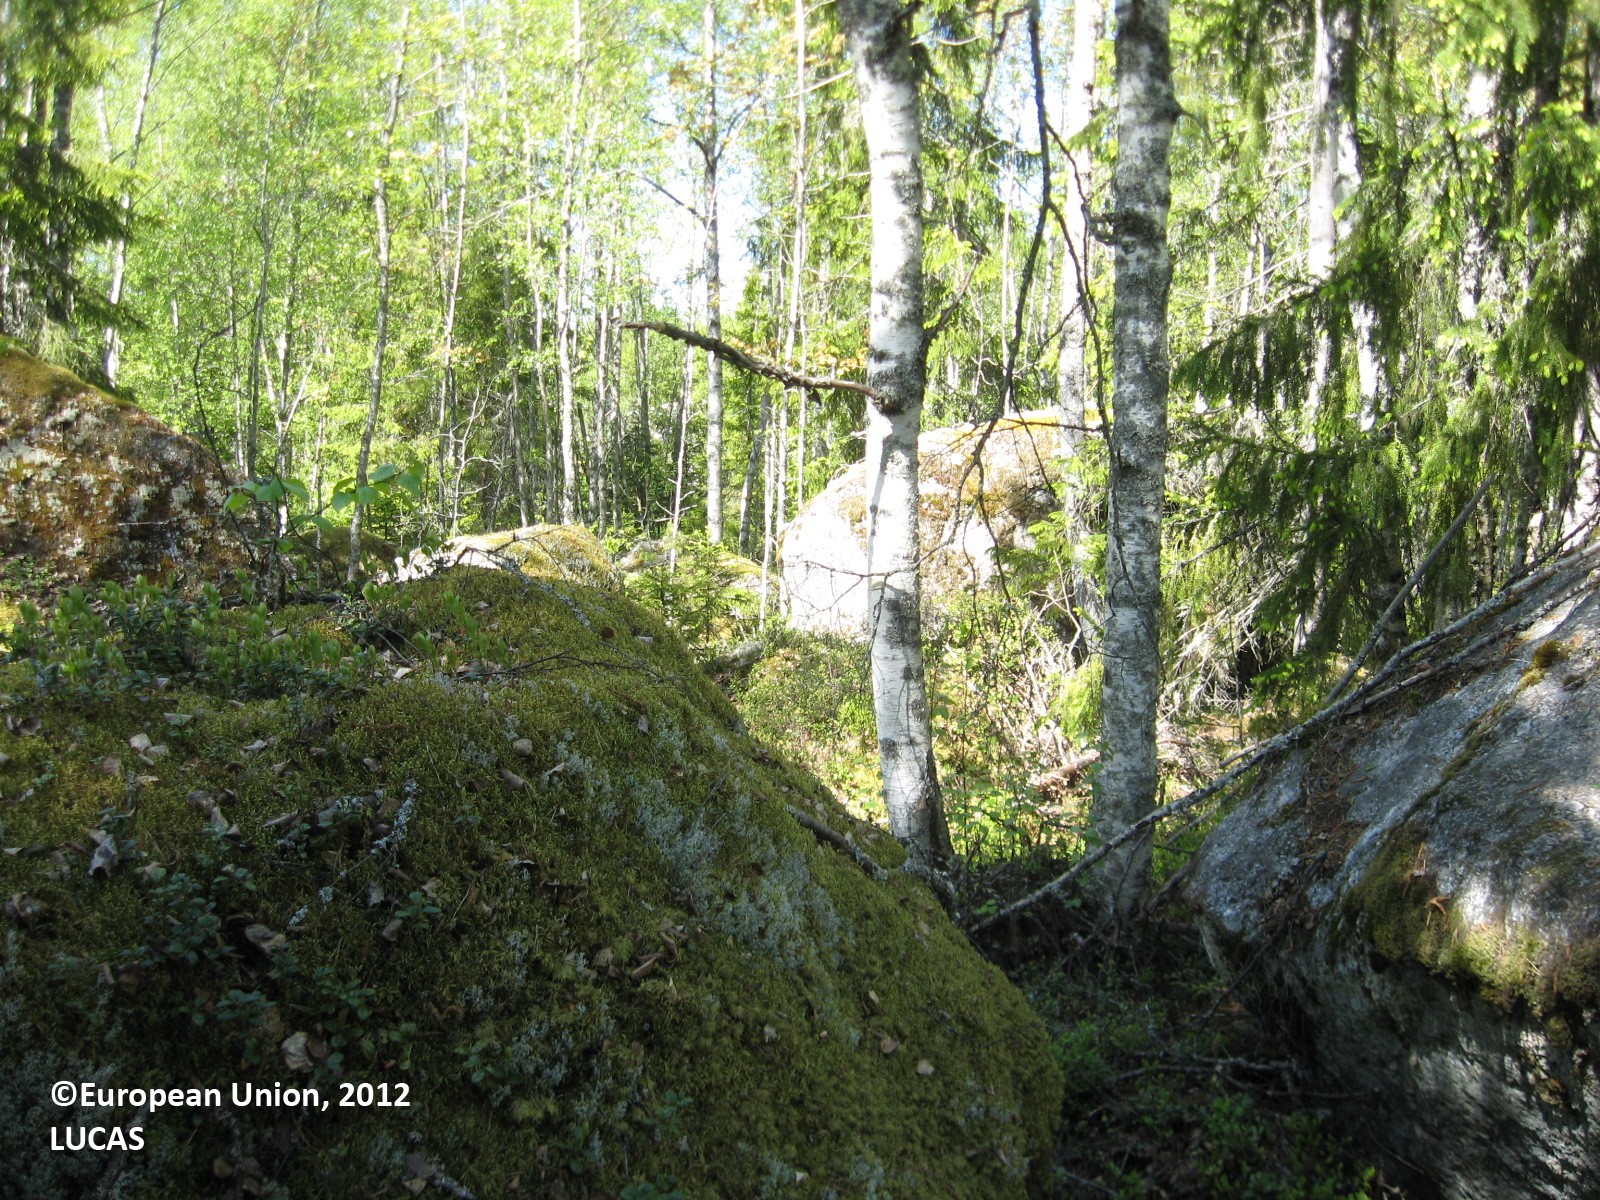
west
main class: Woodland
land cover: Spruce dominated coniferous woodland
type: boreal forest
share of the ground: 50 - 75 %
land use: Forestry
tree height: > 5 m
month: June
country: FI
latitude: 63.1569
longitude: 21.7326
